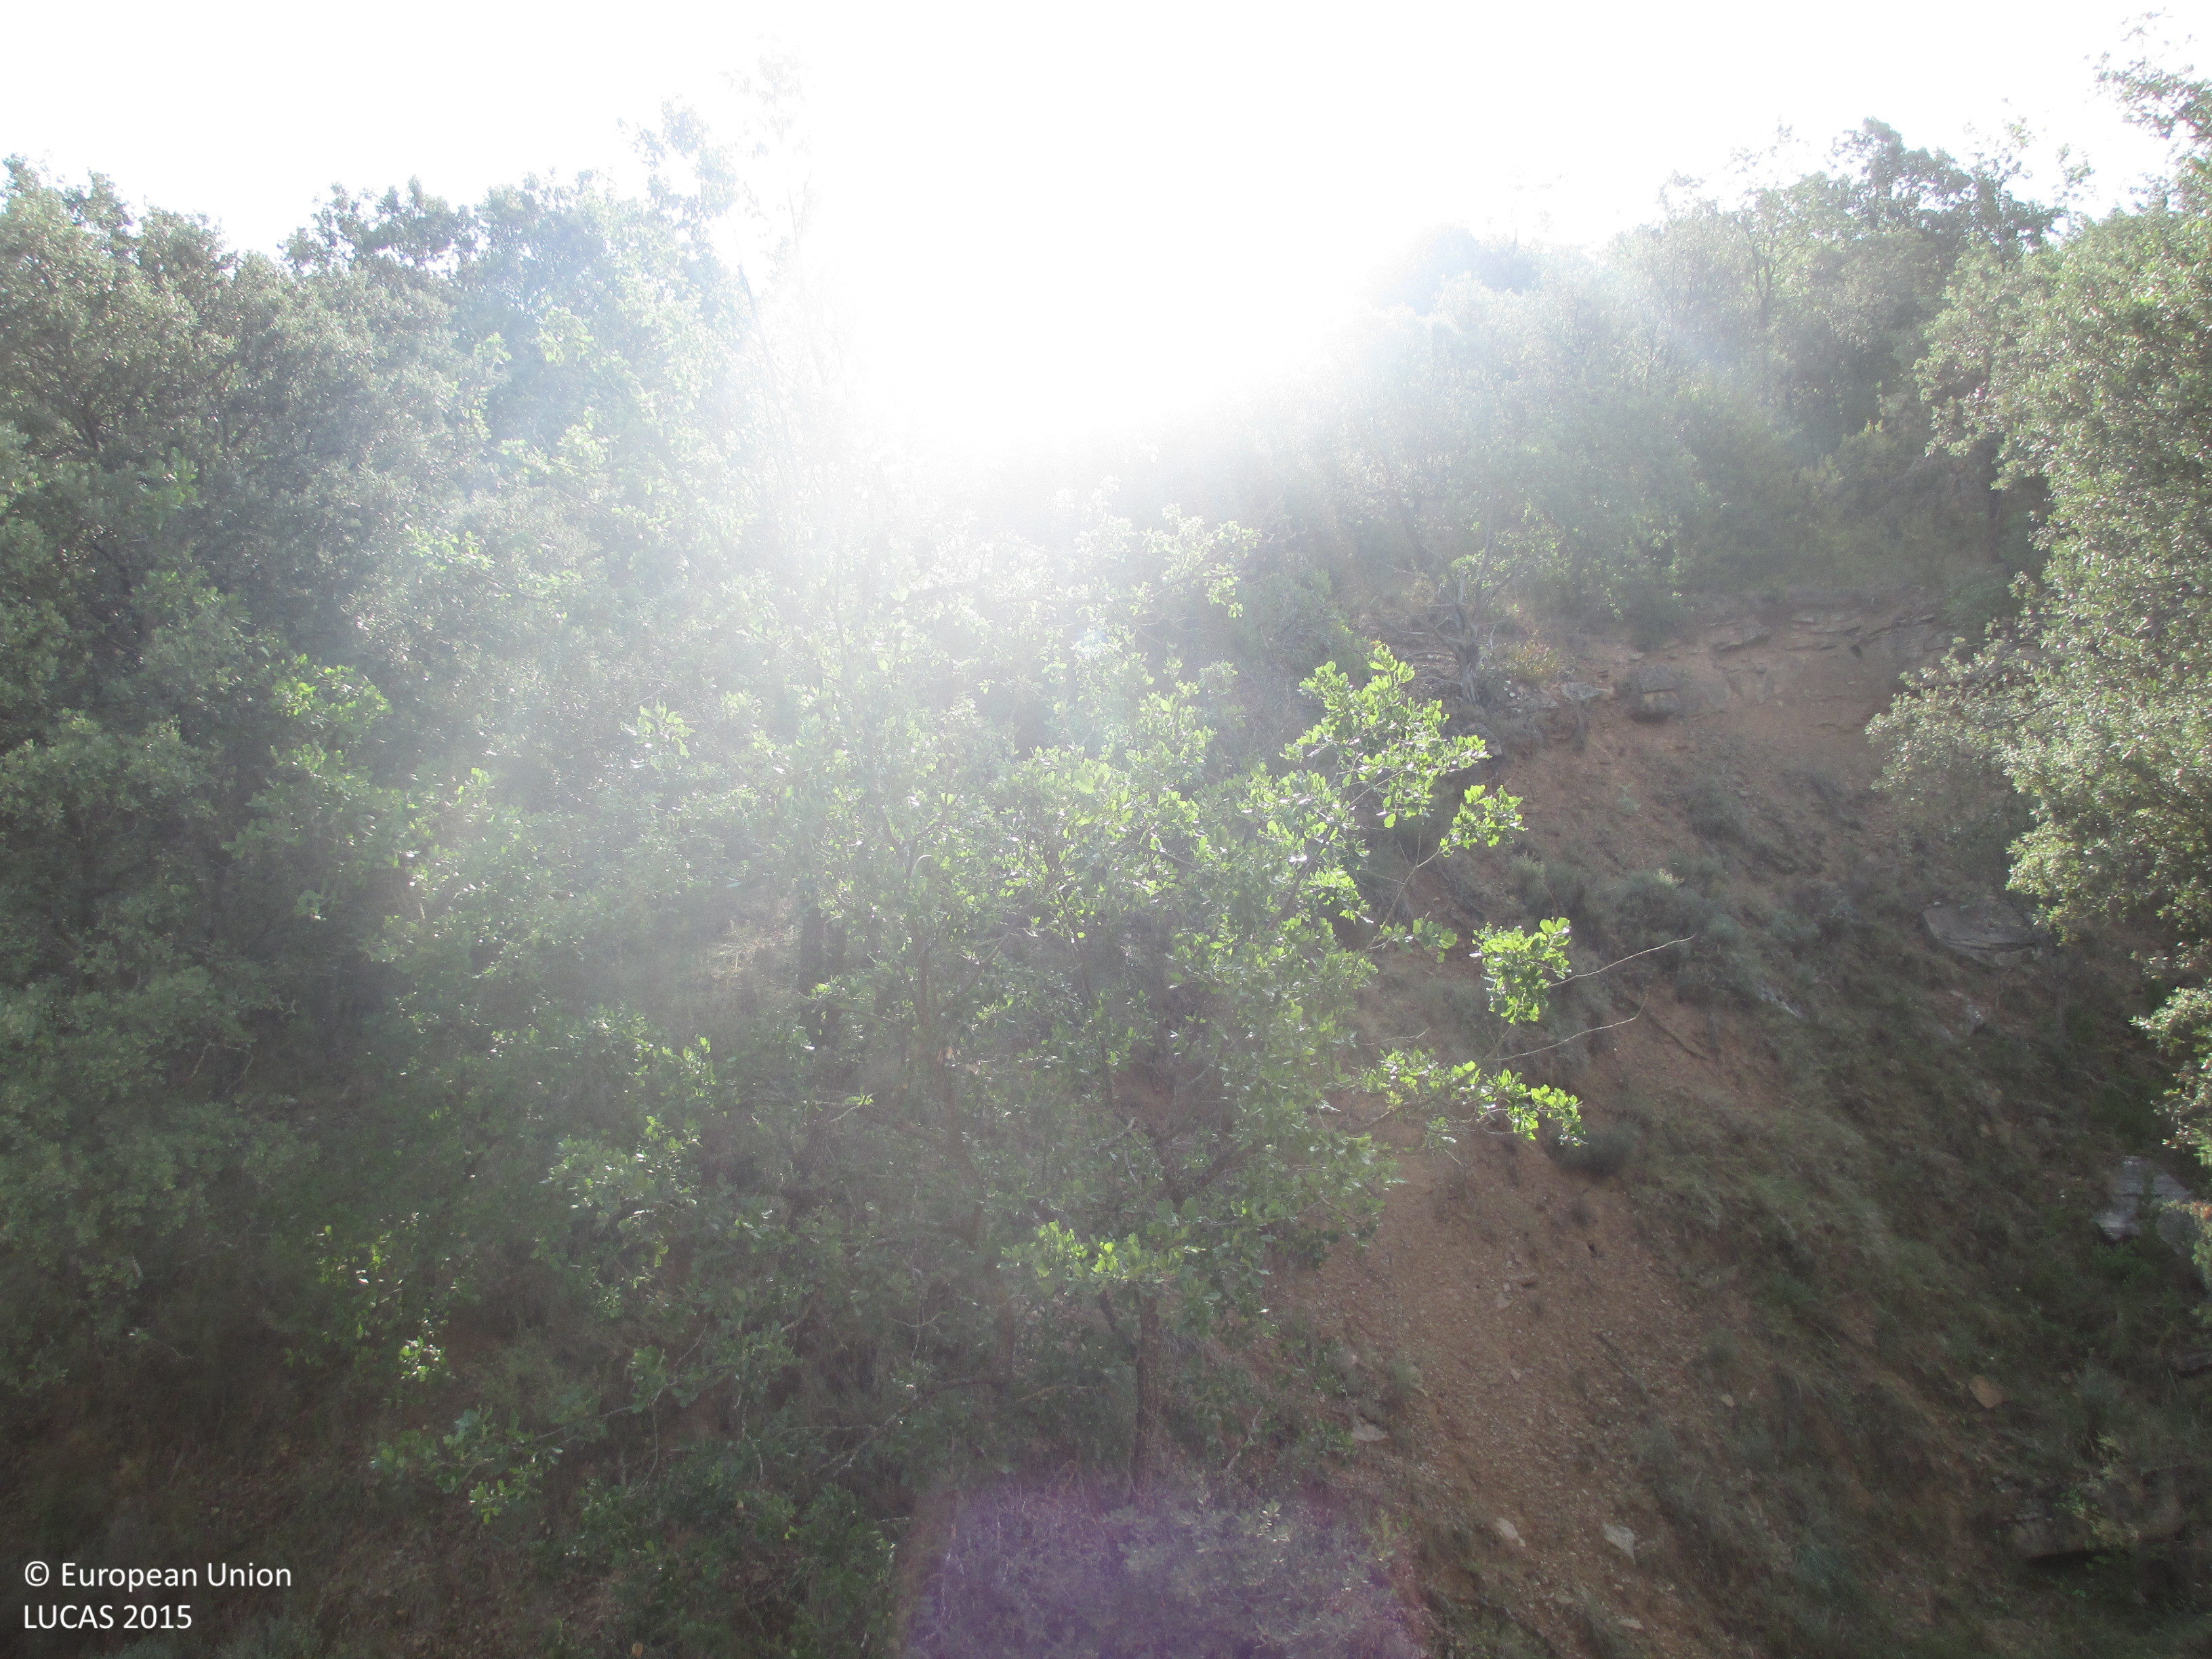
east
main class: Woodland
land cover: Broadleaved woodland
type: broadleaved evergreen forest
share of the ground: > 75 %
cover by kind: broadleaved forest trees 95 %, shrubs 5 %
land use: Semi-natural and natural areas not in use
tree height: < 5 m
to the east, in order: Broadleaved woodland; Electric lines; Broadleaved woodland; Rivers and streams; Broadleaved woodland; Paved roads, cycling and walking lanes; Broadleaved woodland; Nuts trees; Broadleaved woodland
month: July
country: ES
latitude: 42.1032
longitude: 0.3692
